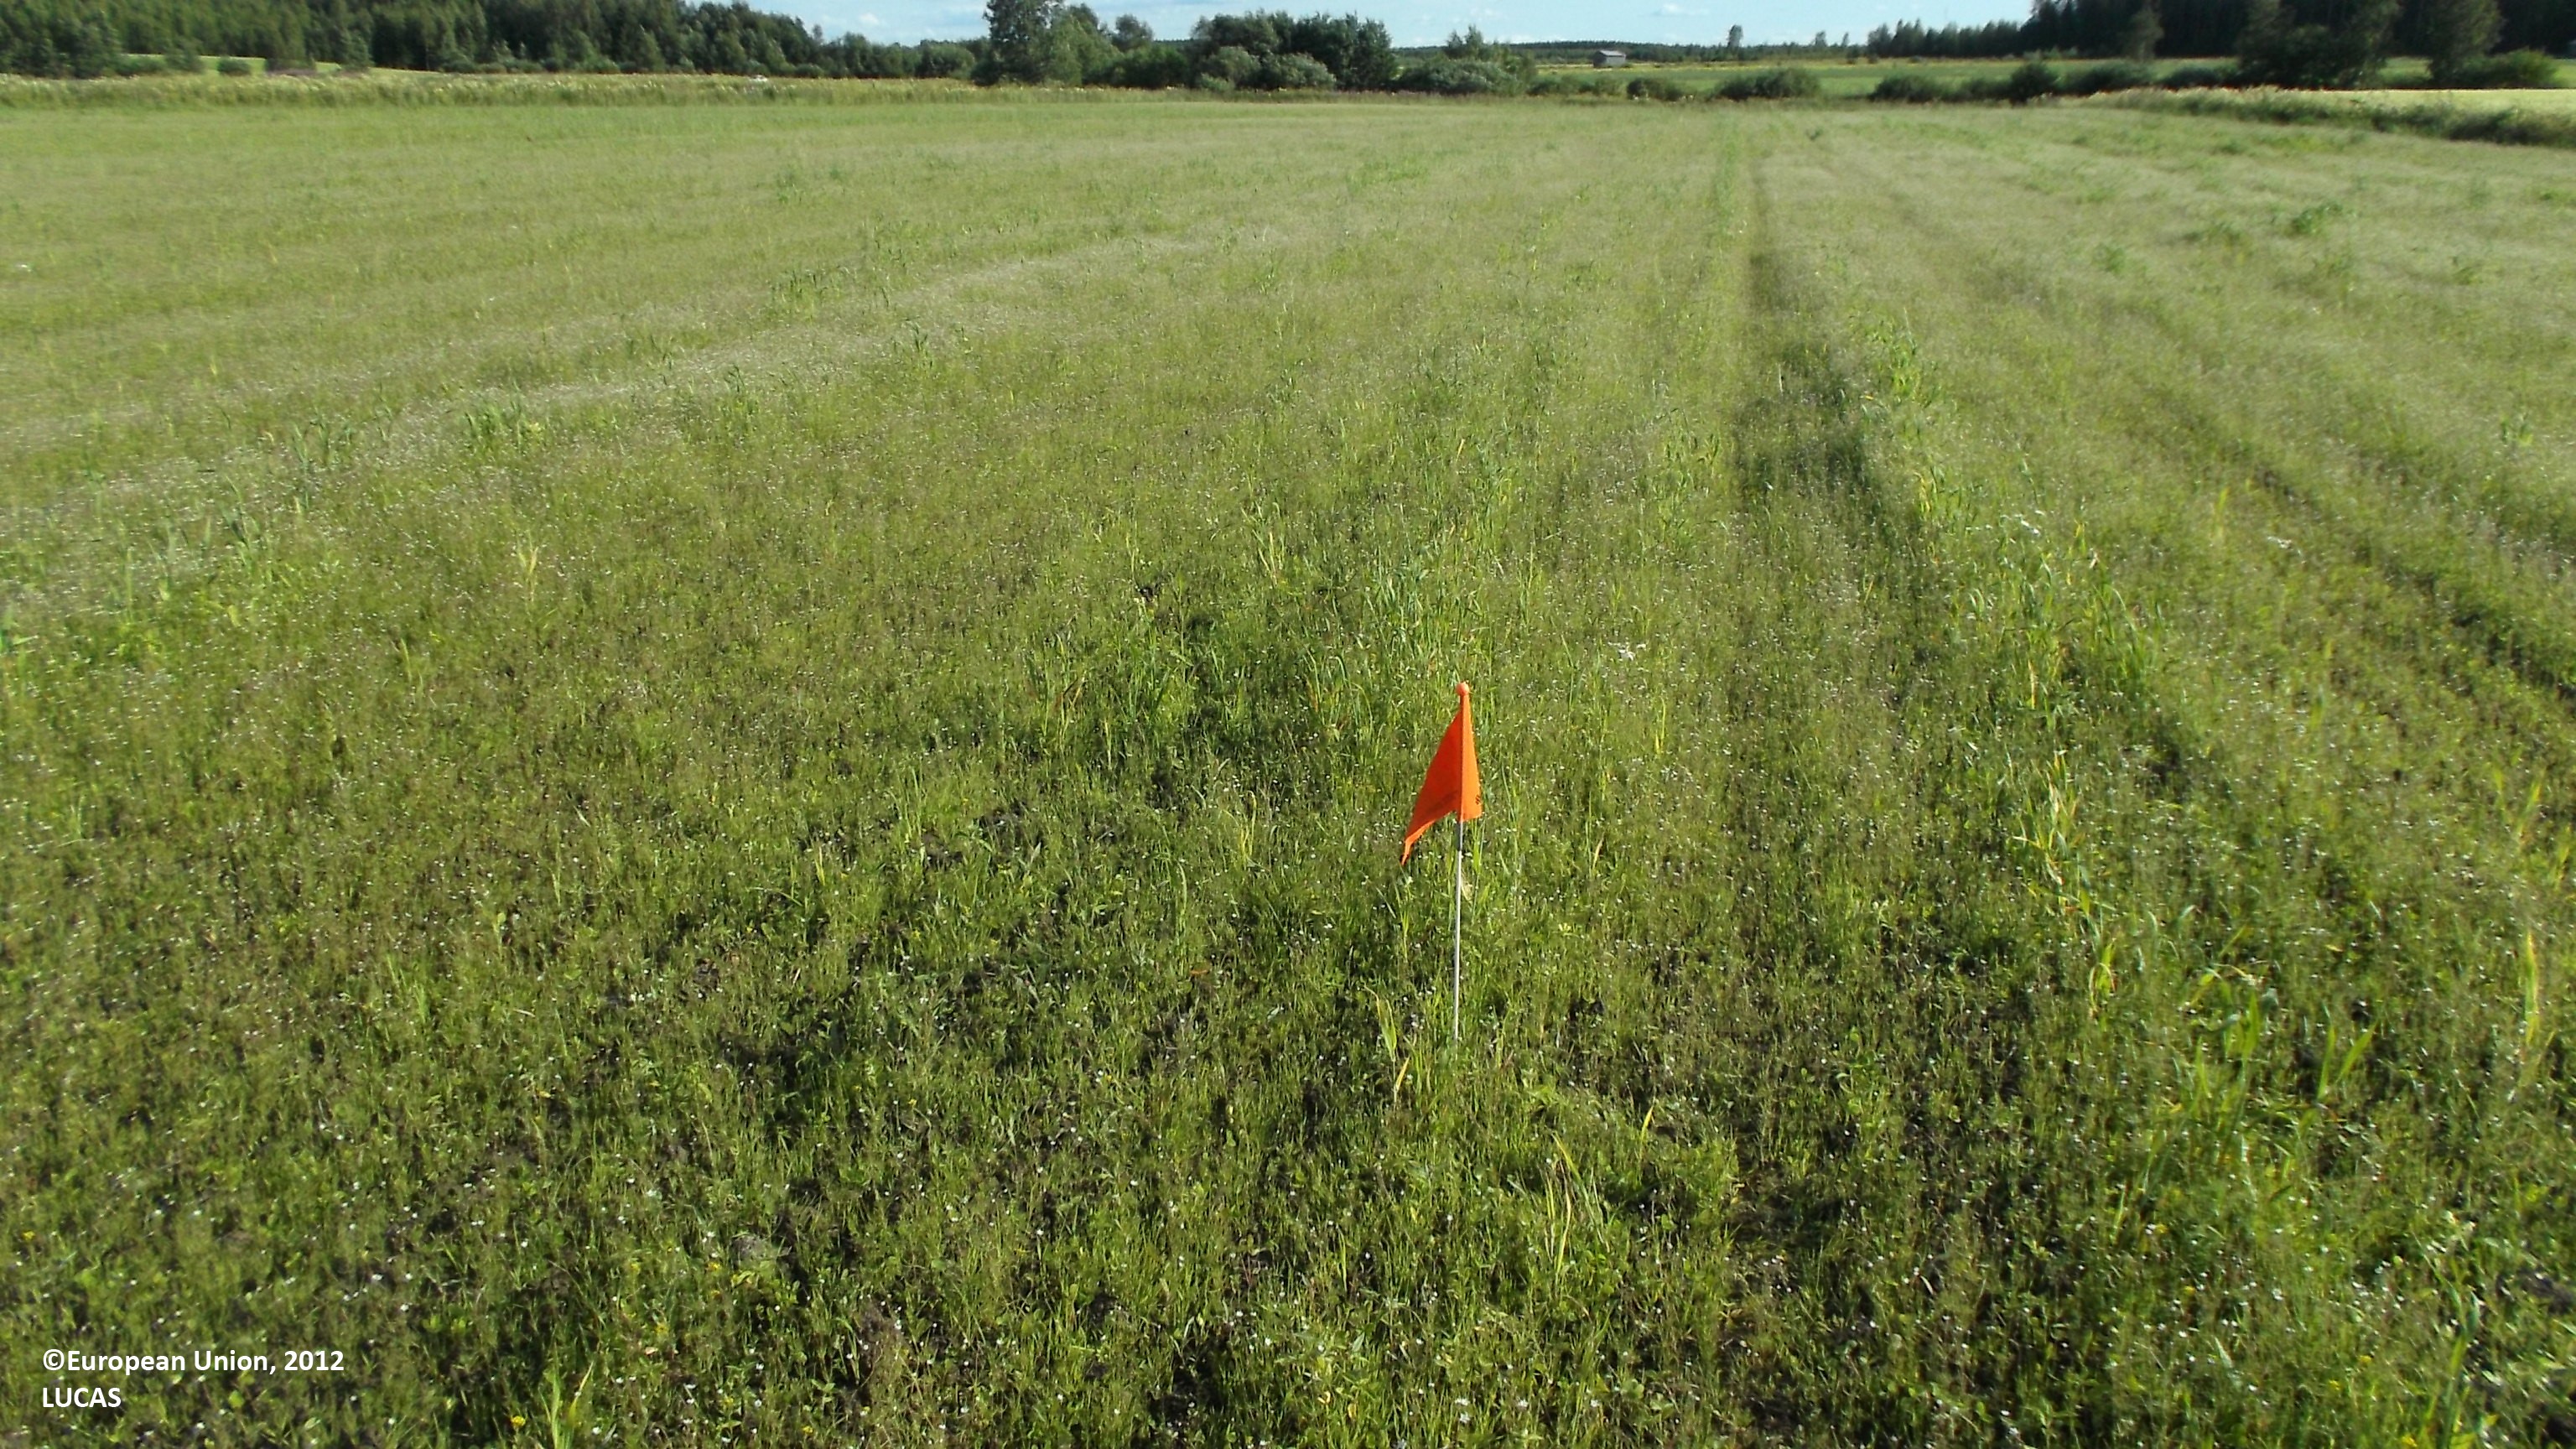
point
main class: Cropland
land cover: Other non-permanent industrial crops
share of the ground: < 10 %
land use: Agriculture (excluding fallow land and kitchen gardens)
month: July
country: FI
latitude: 63.2413
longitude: 23.7859
